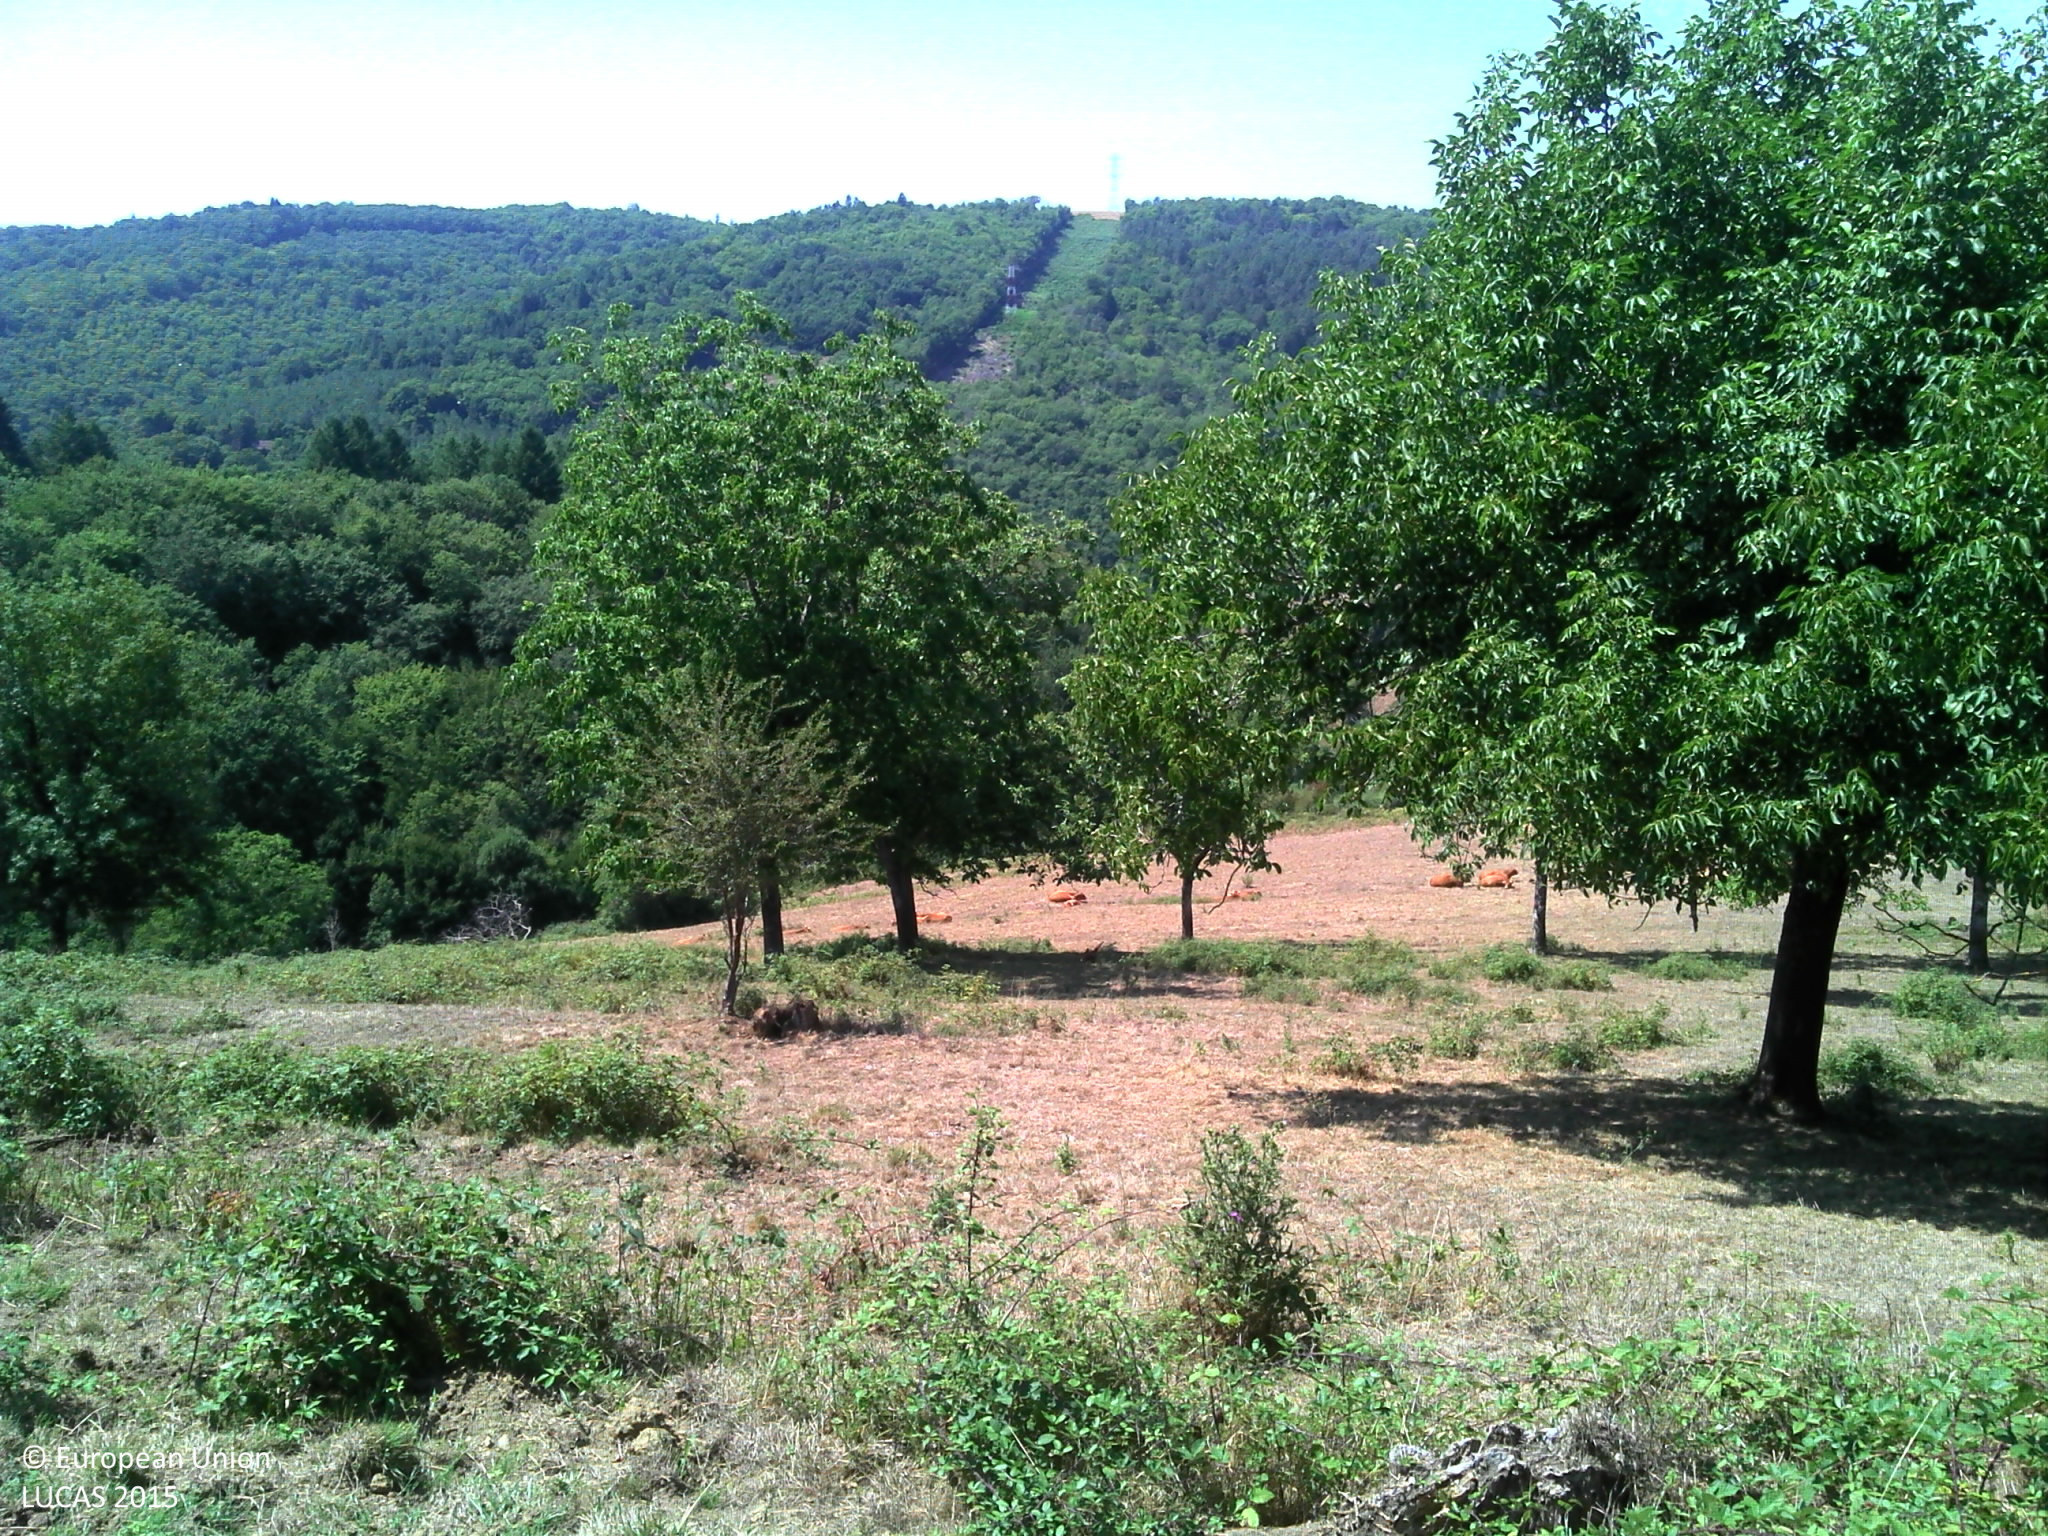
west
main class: Grassland
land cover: Grassland without tree/shrub cover
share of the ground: > 75 %
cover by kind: herbaceous plants 95 %, shrubs 5 %
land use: Agriculture (excluding fallow land and kitchen gardens)
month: August
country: FR
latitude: 45.2935
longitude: 1.7971
